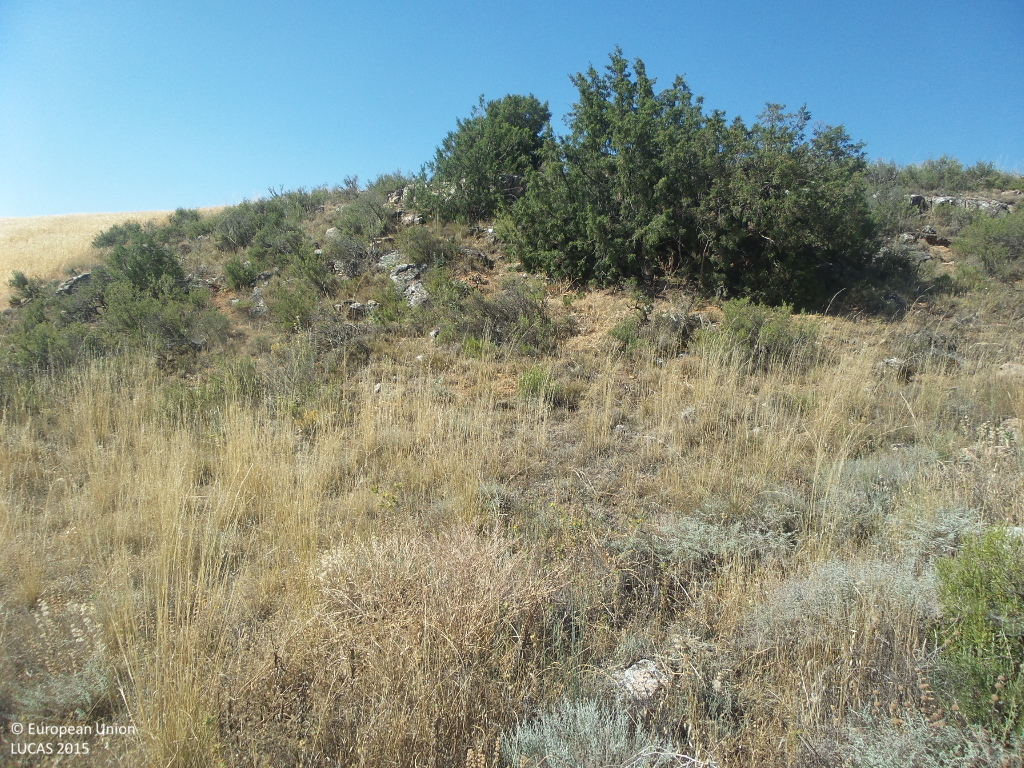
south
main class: Shrubland
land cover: Shrubland without tree cover
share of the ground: 50 - 75 %
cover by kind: shrubs 60 %, unconsolidated bare surface 25 %, herbaceous plants 10 %, consolidated bare surface 5 %
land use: Semi-natural and natural areas not in use
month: July
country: ES
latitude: 41.3140
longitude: -2.1785
